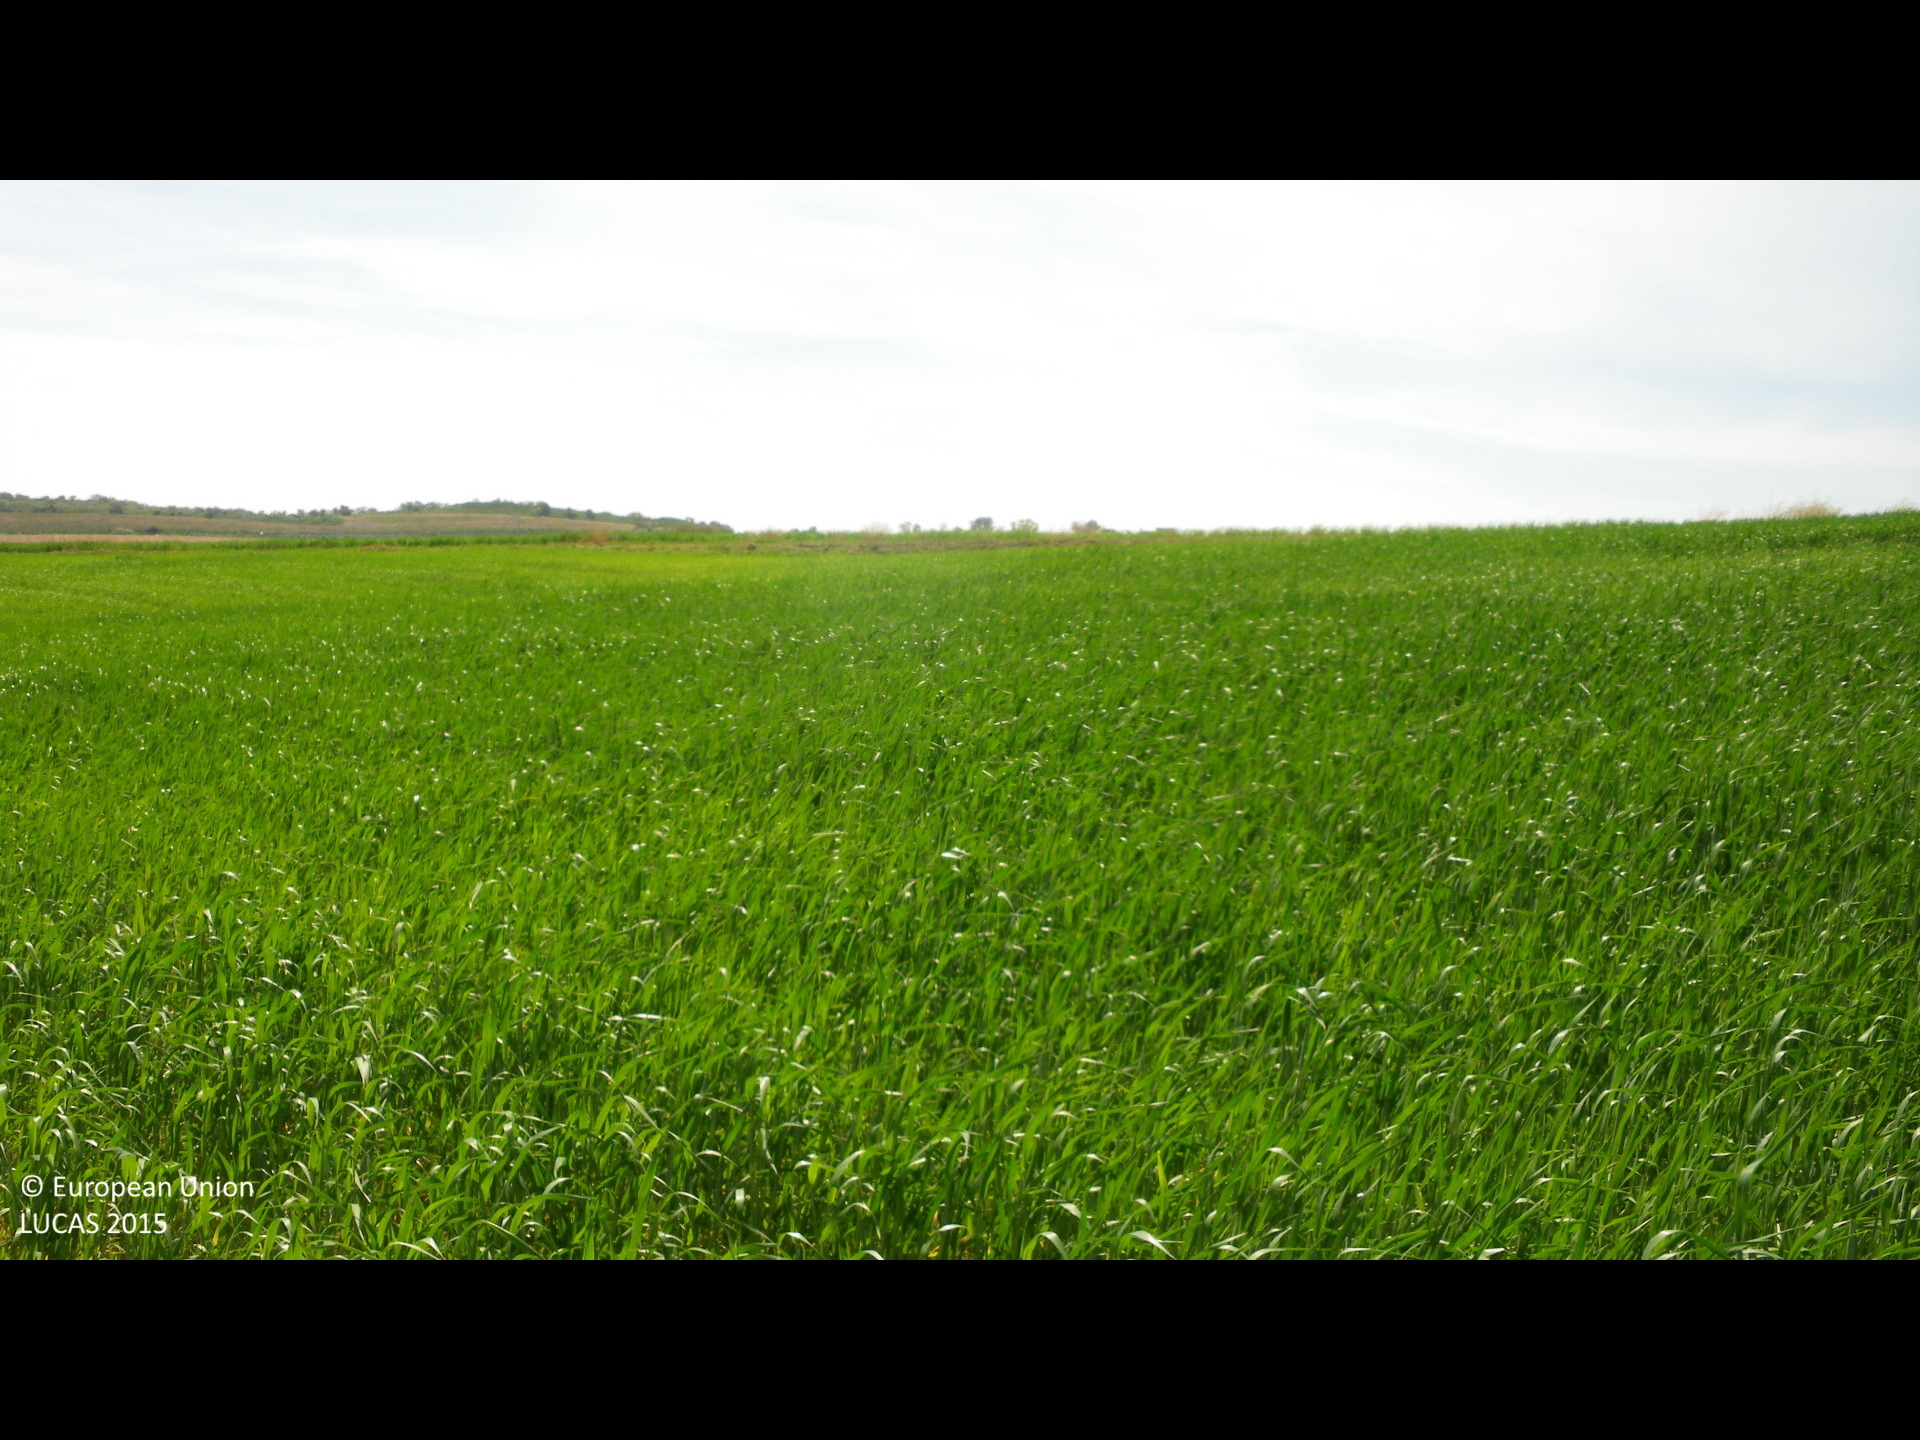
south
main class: Cropland
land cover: Common wheat
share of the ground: > 75 %
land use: Agriculture (excluding fallow land and kitchen gardens)
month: April
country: ES
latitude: 36.6442
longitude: -6.1972
